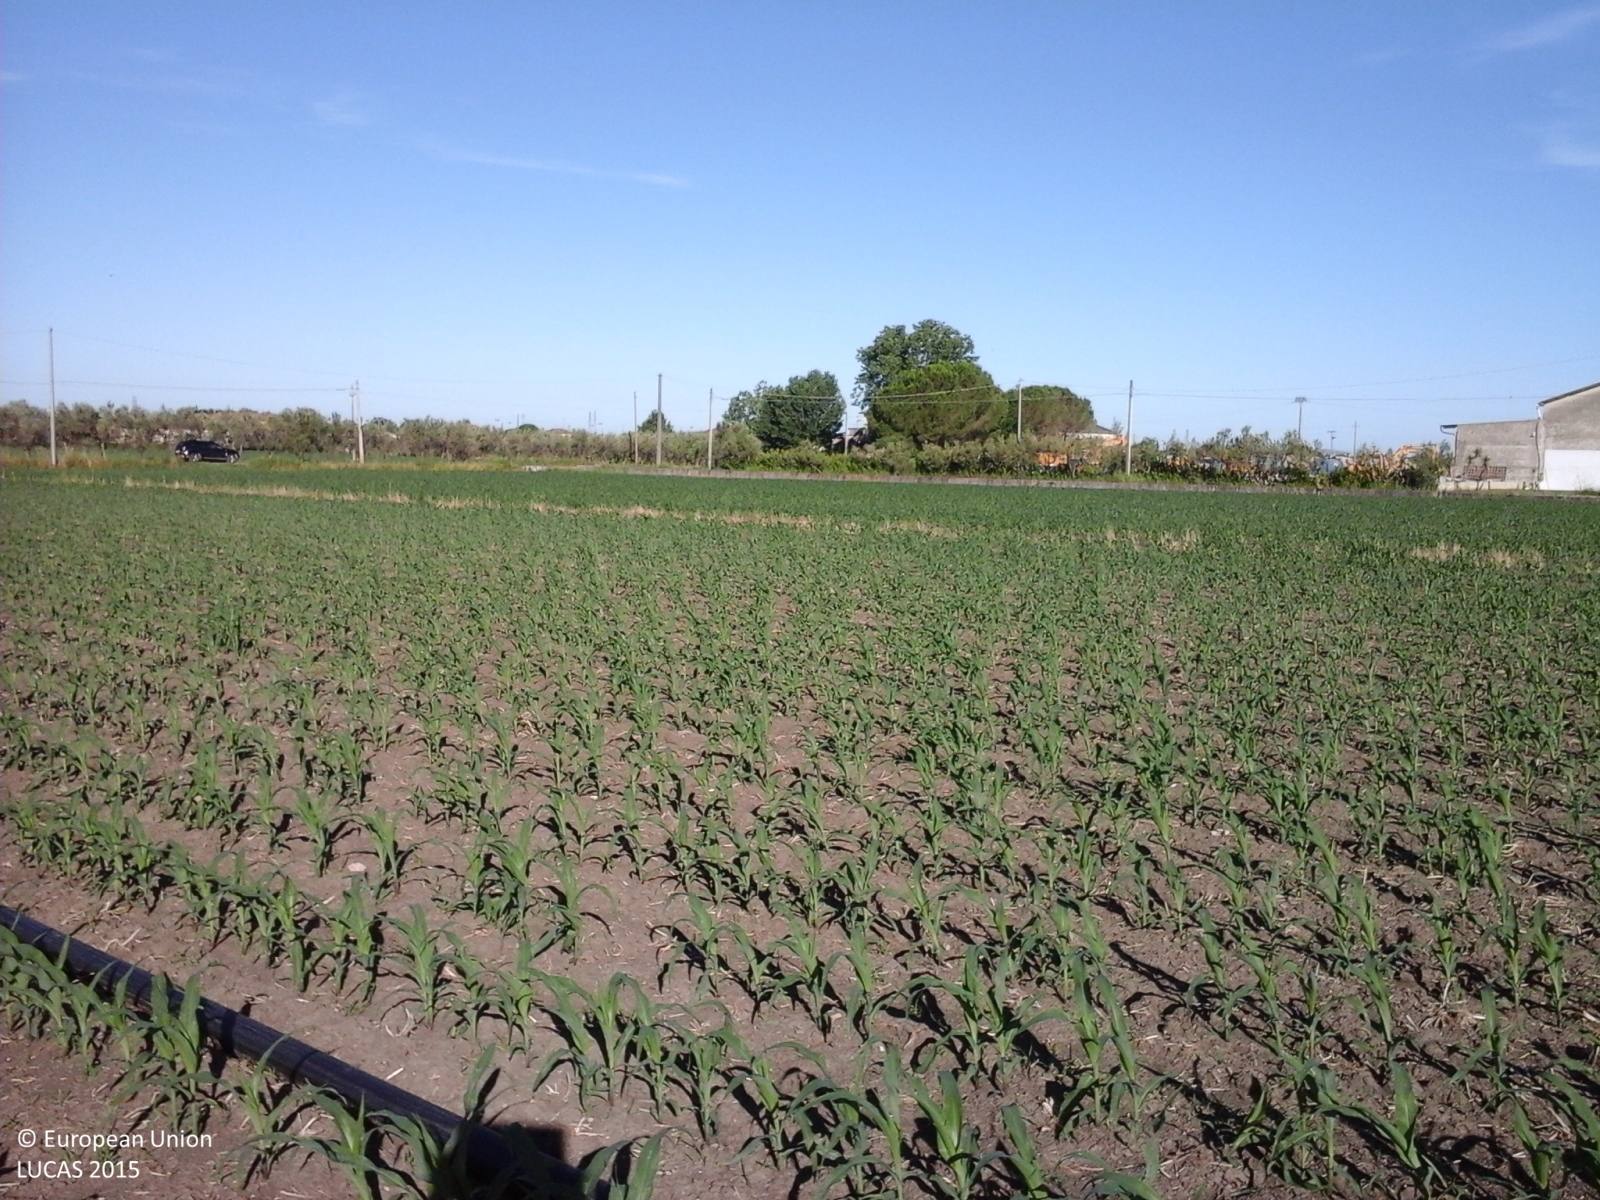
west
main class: Cropland
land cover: Maize
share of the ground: 25 - 50 %
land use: Agriculture (excluding fallow land and kitchen gardens)
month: June
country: IT
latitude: 40.4100
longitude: 15.0336
